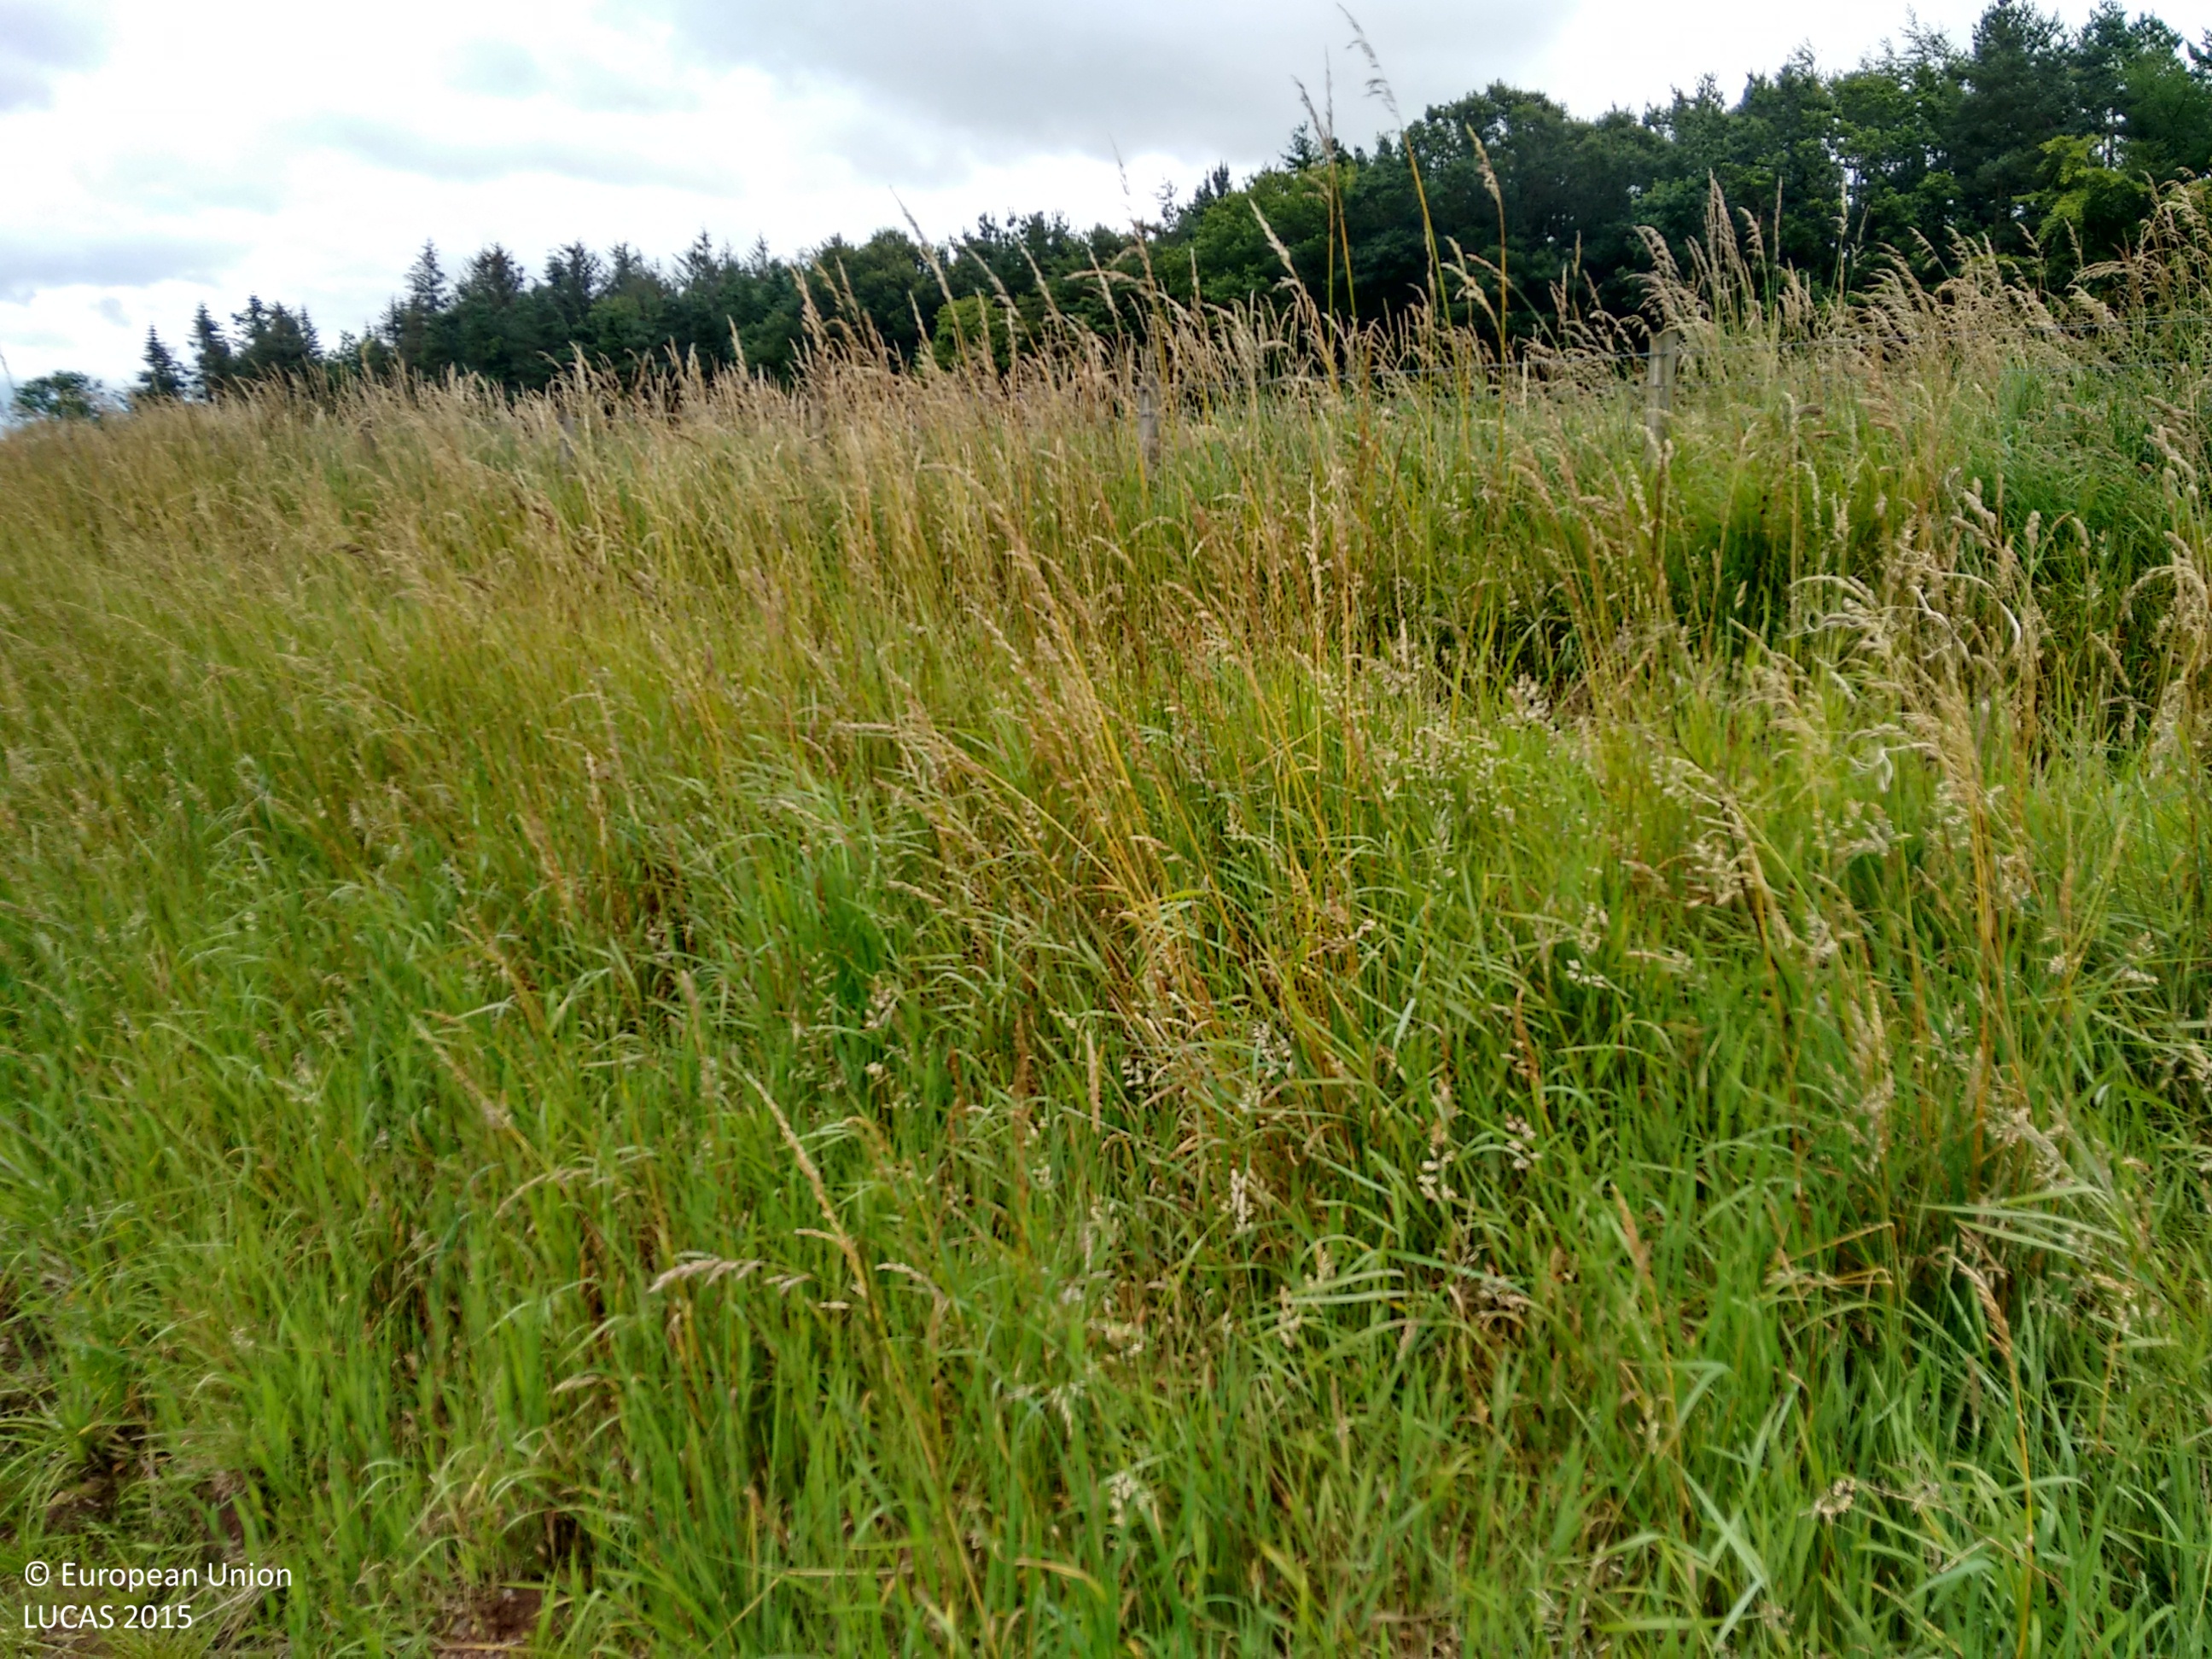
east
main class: Cropland
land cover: Dry pulses
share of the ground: > 75 %
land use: Agriculture (excluding fallow land and kitchen gardens)
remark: Tilled/Sowed
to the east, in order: Dry pulses; Grass margins; Tracks; Grass margins; Fences; Grass margins; Common wheat; Spontaneously vegetated surfaces; Fences; Grass margins; Paved roads, cycling and walking lanes; Grass margins; Other mixed woodland; Rivers and streams; Other mixed woodland
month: August
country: GB
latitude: 55.5940
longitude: -2.2920
